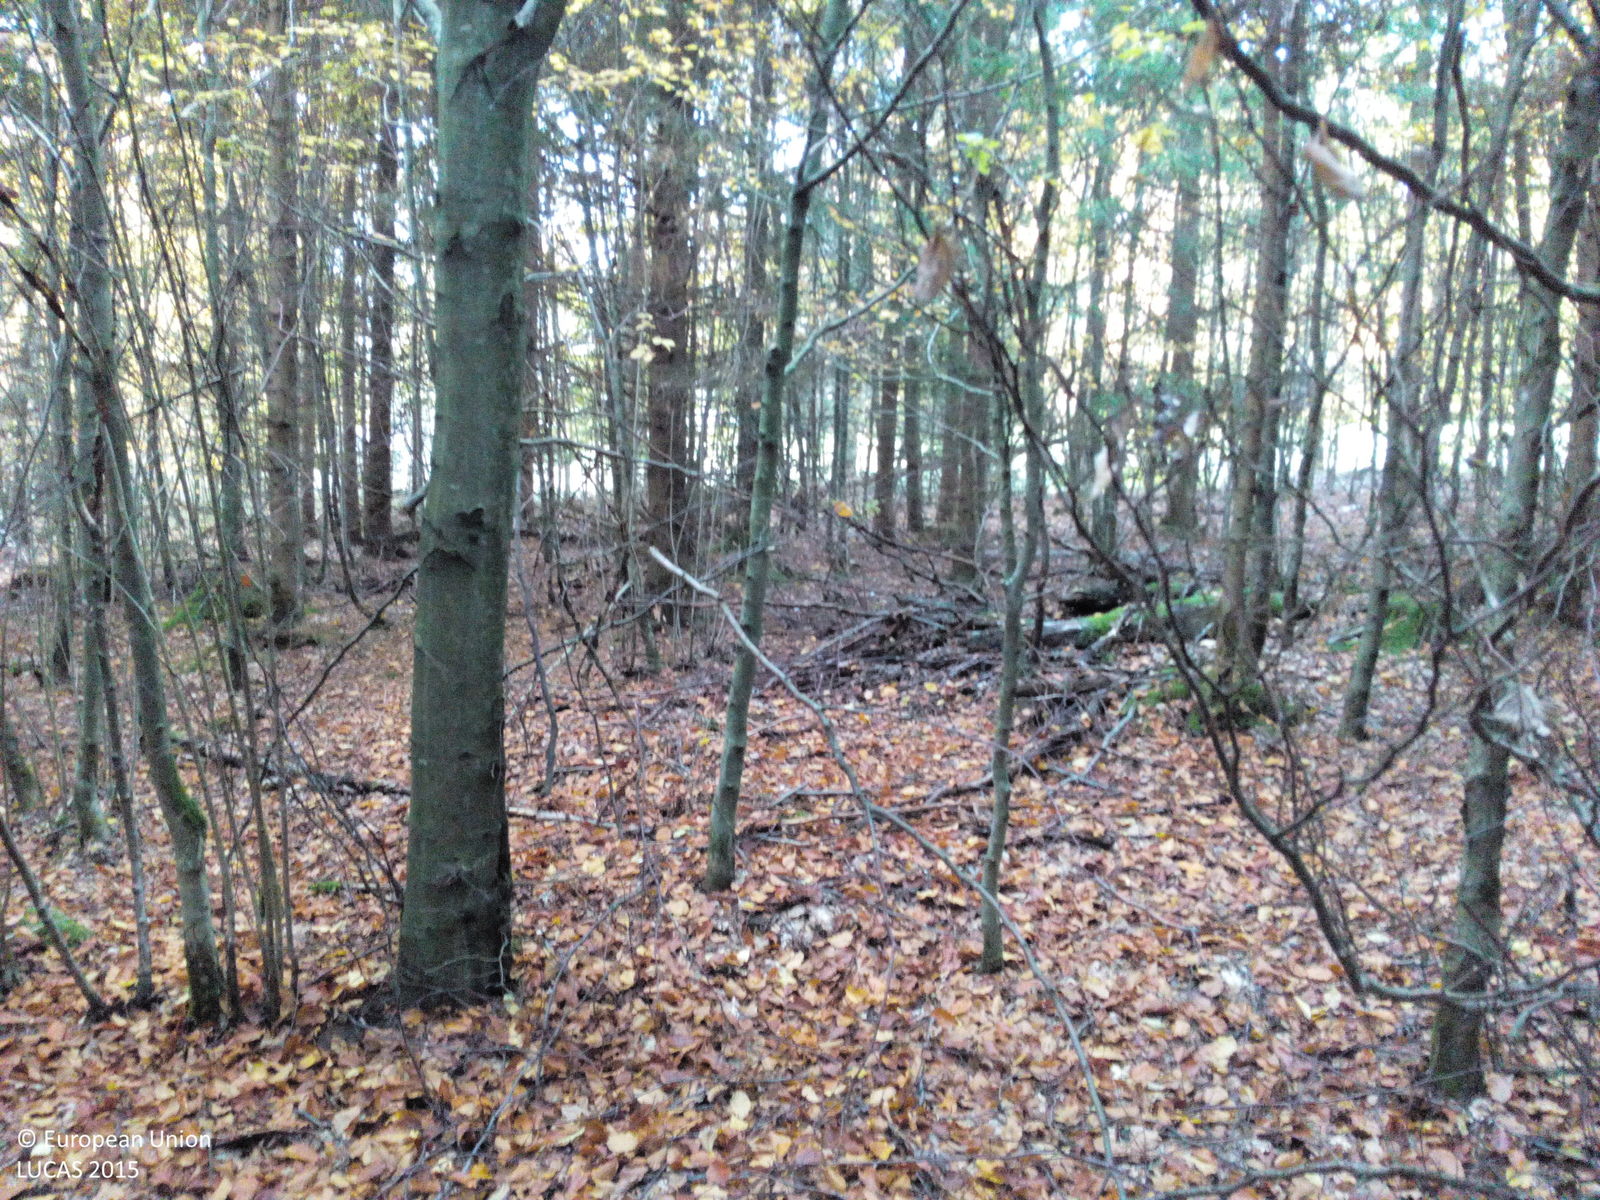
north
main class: Woodland
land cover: Spruce dominated mixed woodland
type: hemiboreal forest and nemoral coniferous forest and mixed broadleaved-coniferous forest
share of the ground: > 75 %
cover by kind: coniferous forest trees 45 %, broadleaved forest trees 30 %, lichens and mosses 15 %, unconsolidated bare surface 10 %
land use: Forestry
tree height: > 5 m
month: October
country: DE
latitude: 50.3280
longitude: 9.9017
